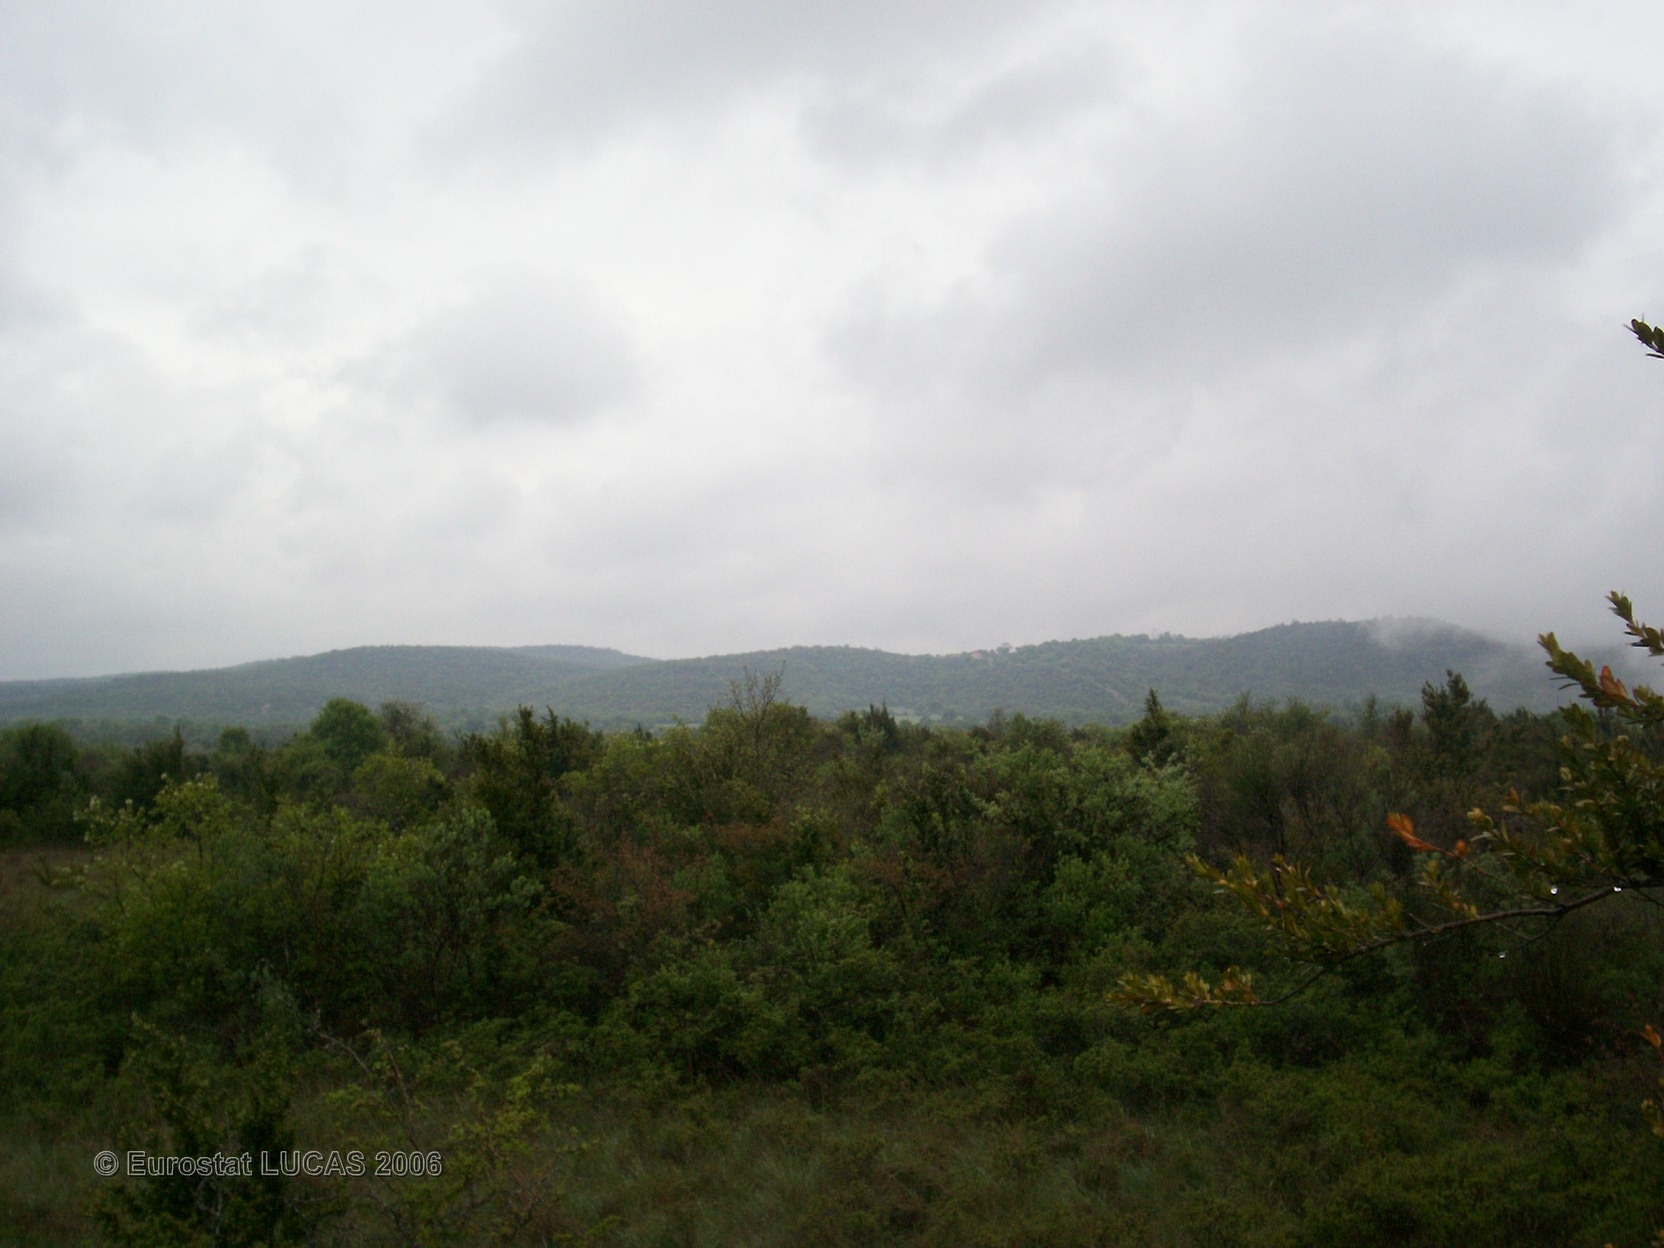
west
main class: Shrubland
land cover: Shrubland without tree cover
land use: Unused
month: May
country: FR
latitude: 43.9291
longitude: 3.4929
